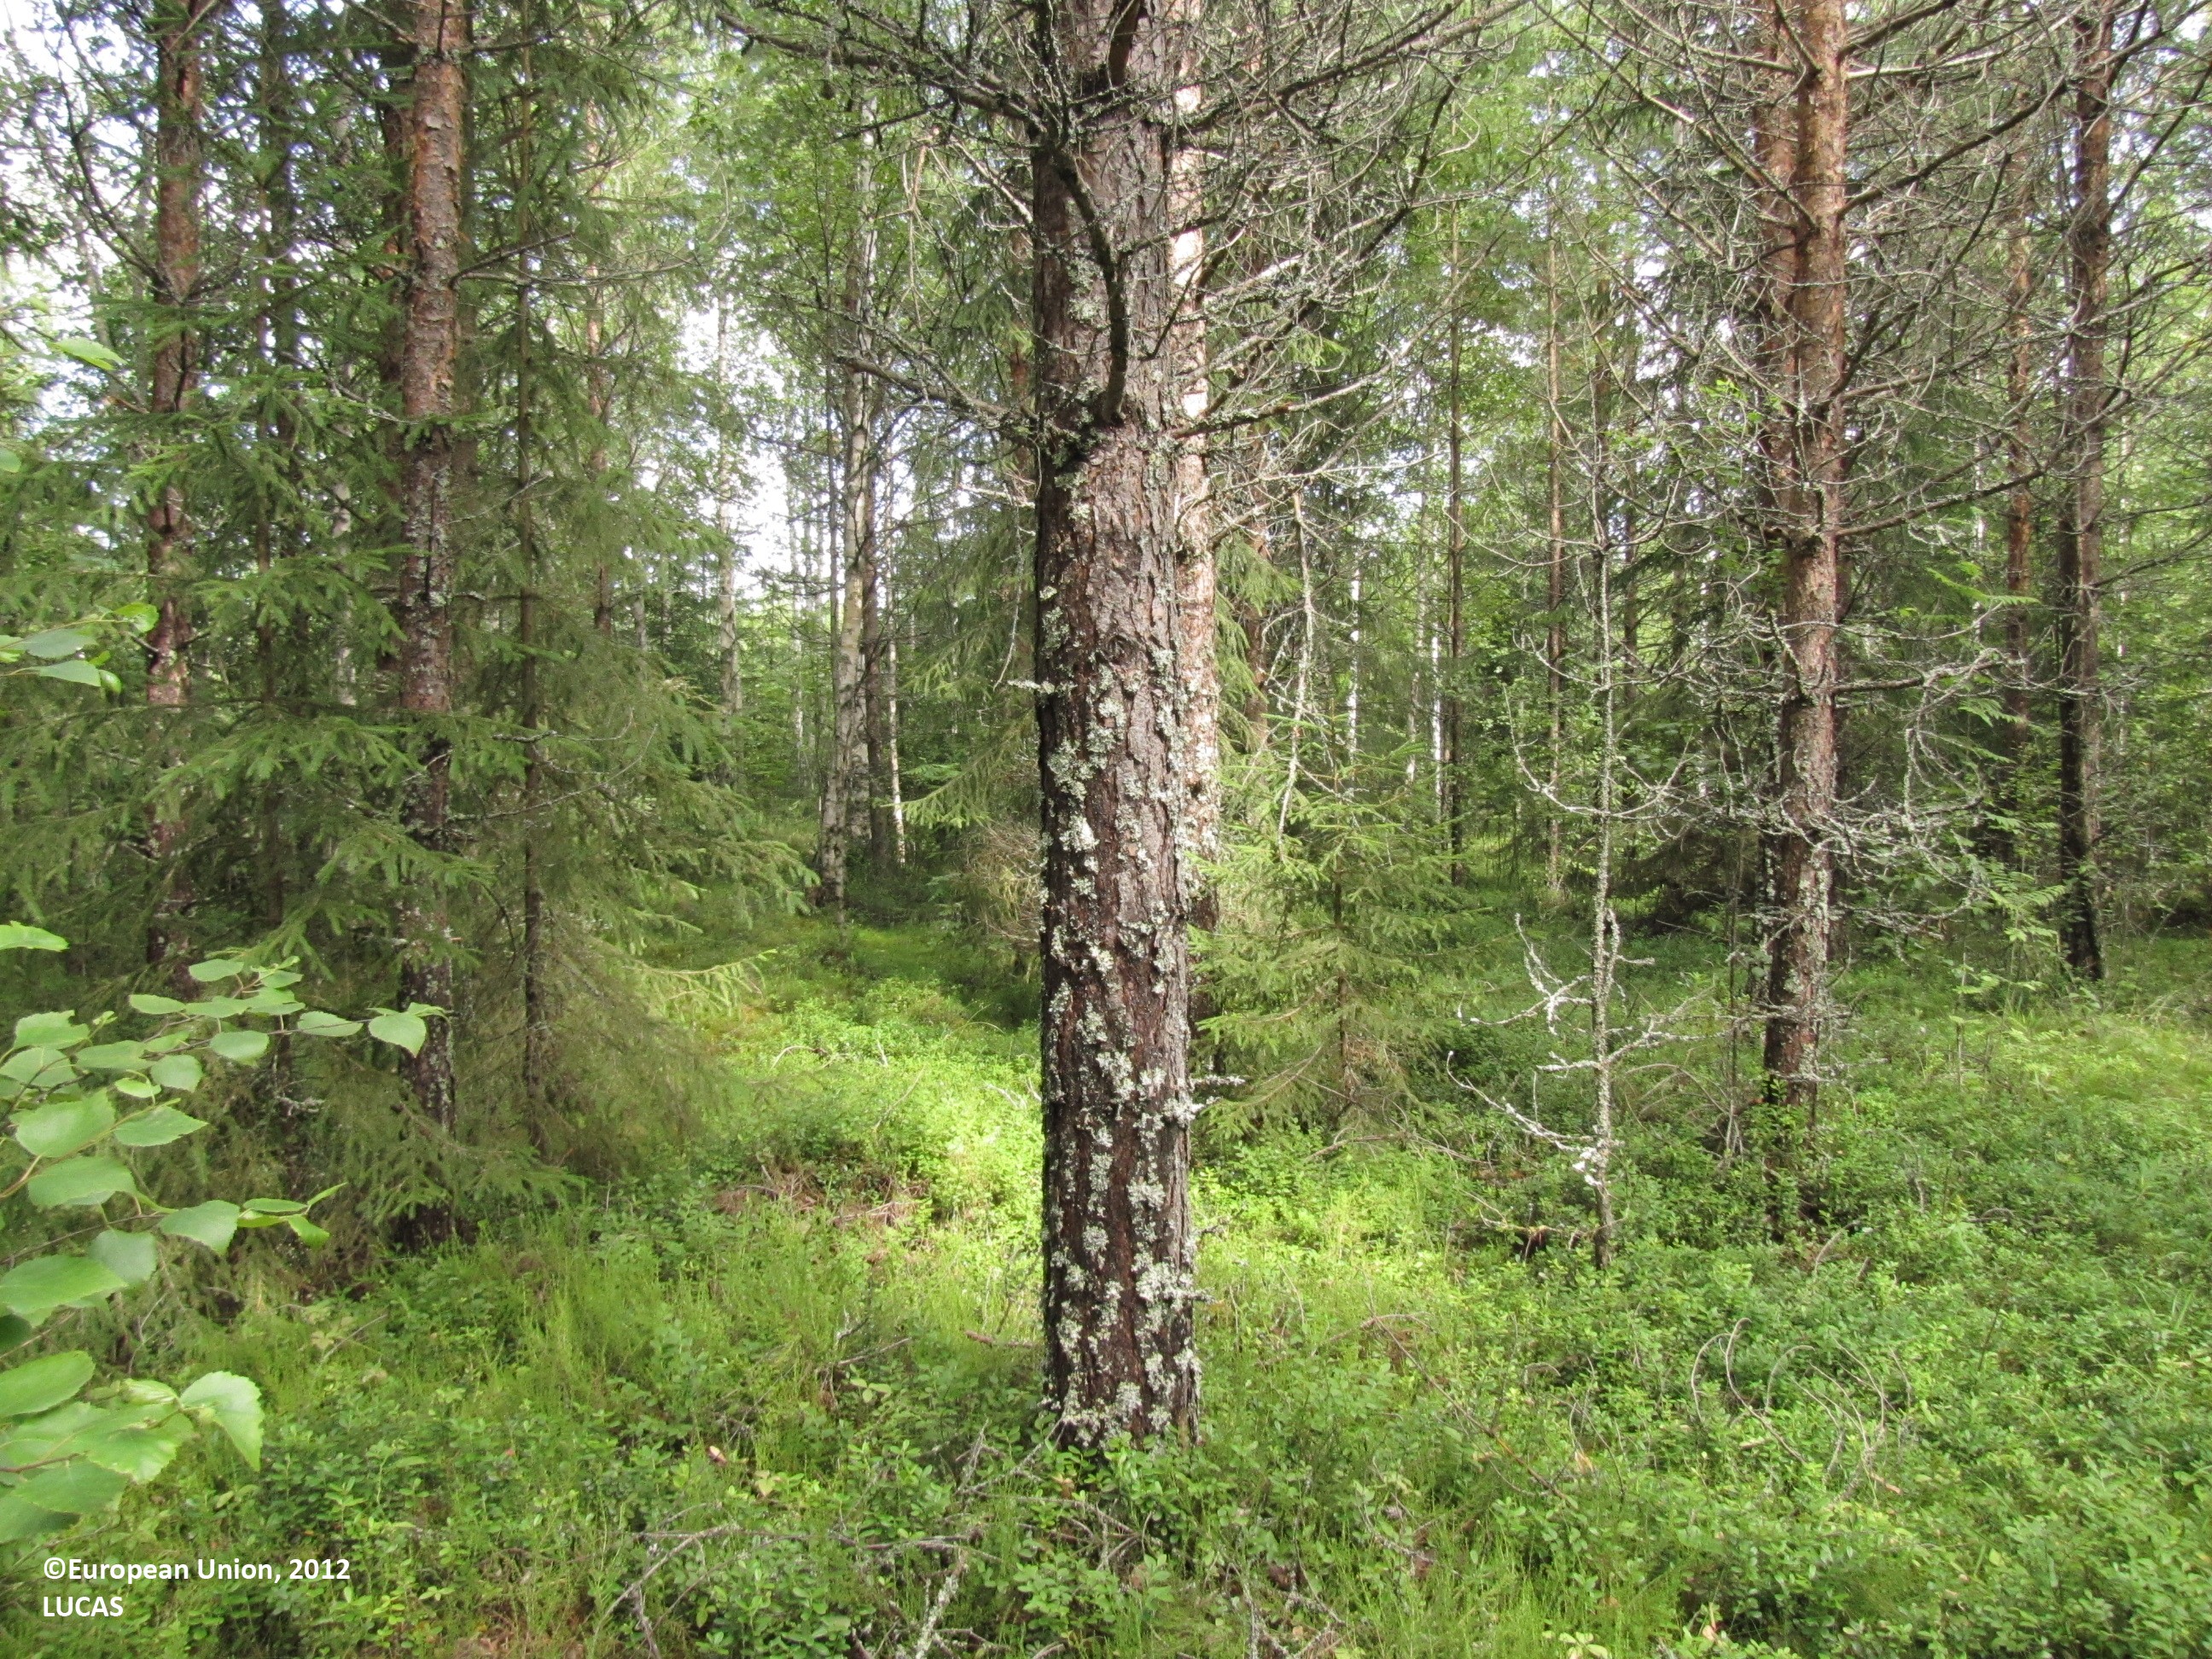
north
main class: Woodland
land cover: Other mixed woodland
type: boreal forest
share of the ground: 50 - 75 %
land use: Forestry
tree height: > 5 m
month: July
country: FI
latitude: 62.2499
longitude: 23.1782
